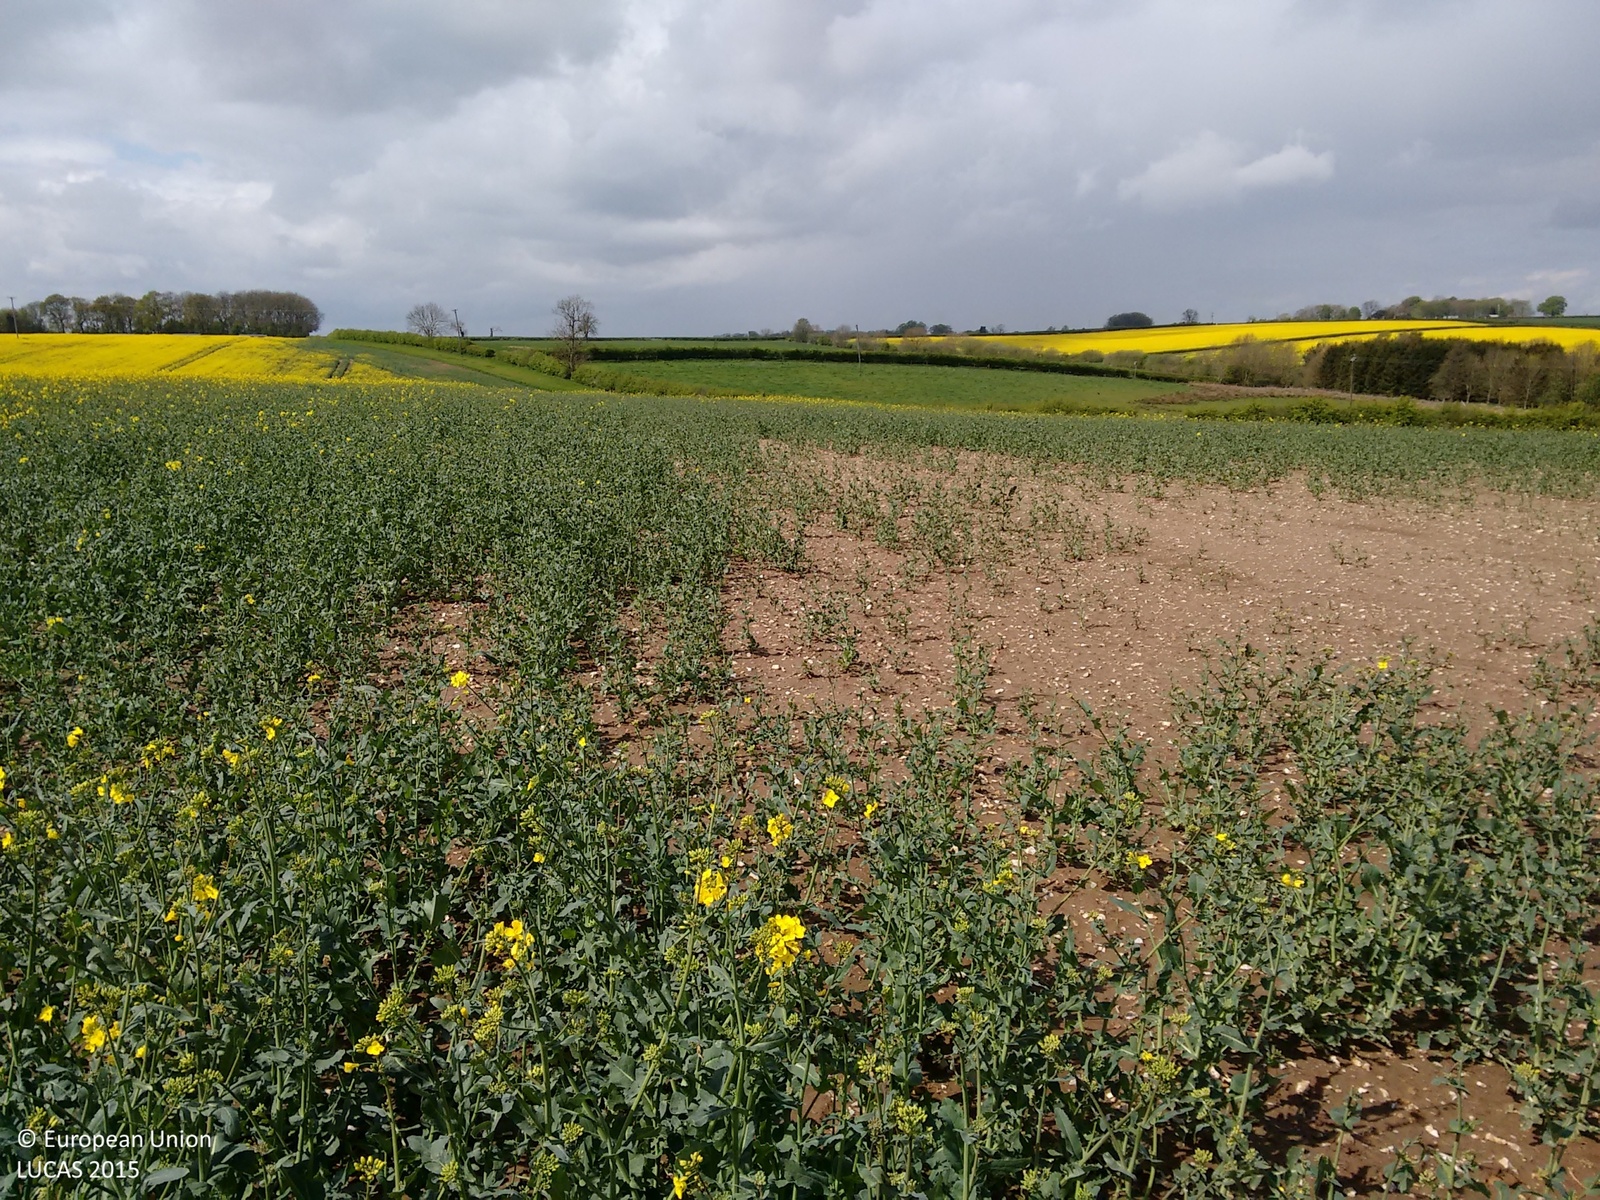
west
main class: Cropland
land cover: Rape and turnip rape
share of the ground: 50 - 75 %
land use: Agriculture (excluding fallow land and kitchen gardens)
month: May
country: GB
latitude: 53.3529
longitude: -0.1746
